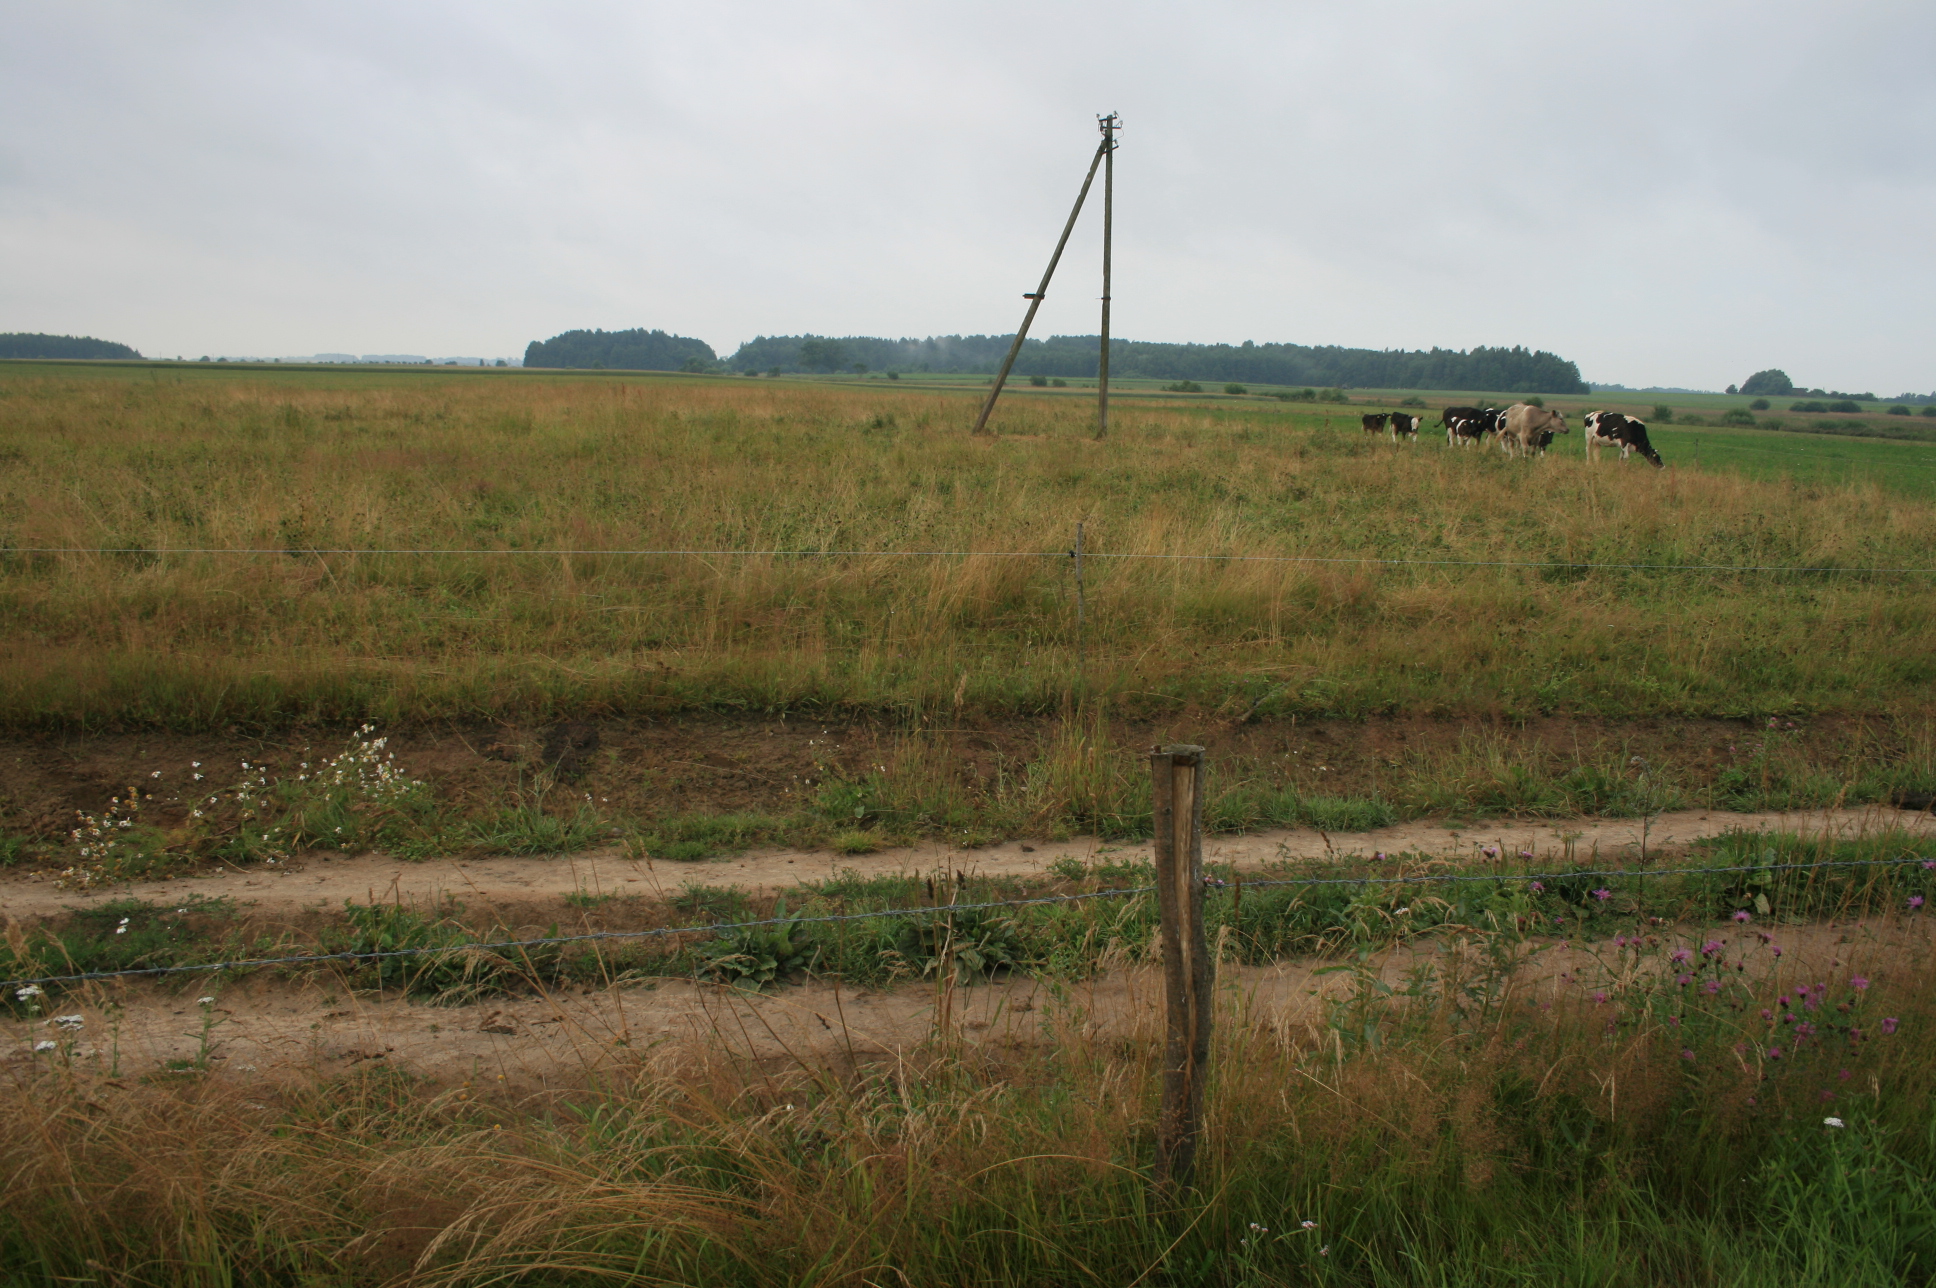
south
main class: Grassland
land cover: Grassland without tree/shrub cover
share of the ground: > 75 %
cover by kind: herbaceous plants 100 %
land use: Agriculture (excluding fallow land and kitchen gardens)
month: July
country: LT
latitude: 55.3707
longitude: 21.7739
